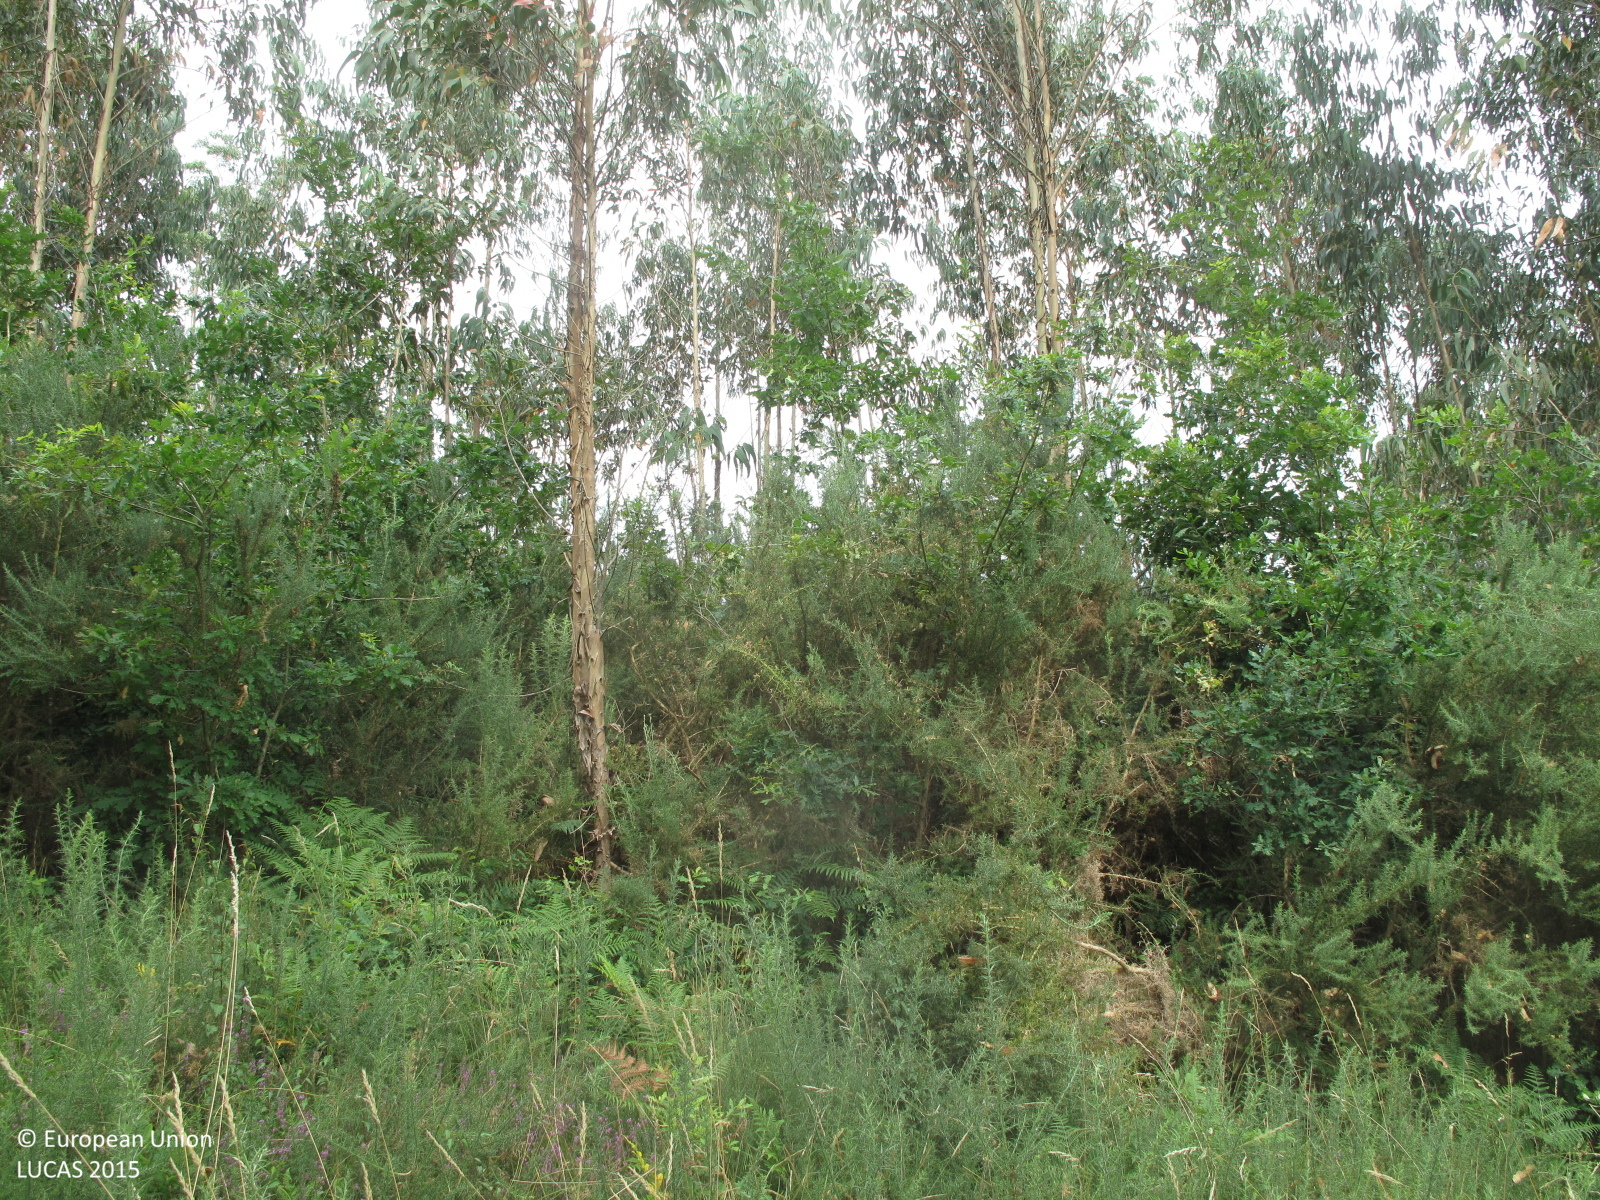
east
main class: Woodland
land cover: Broadleaved woodland
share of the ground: 50 - 75 %
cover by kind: broadleaved forest trees 50 %, shrubs 40 %, herbaceous plants 10 %
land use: Forestry
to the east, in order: Broadleaved woodland; Pine dominated coniferous woodland; Tracks; Broadleaved woodland; Artificial constructions in urban areas; Broadleaved woodland; Tracks; Shrubland without tree cover; Paved roads, cycling and walking lanes; Grass margins; Broadleaved woodland
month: July
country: ES
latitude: 43.2210
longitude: -8.2083
